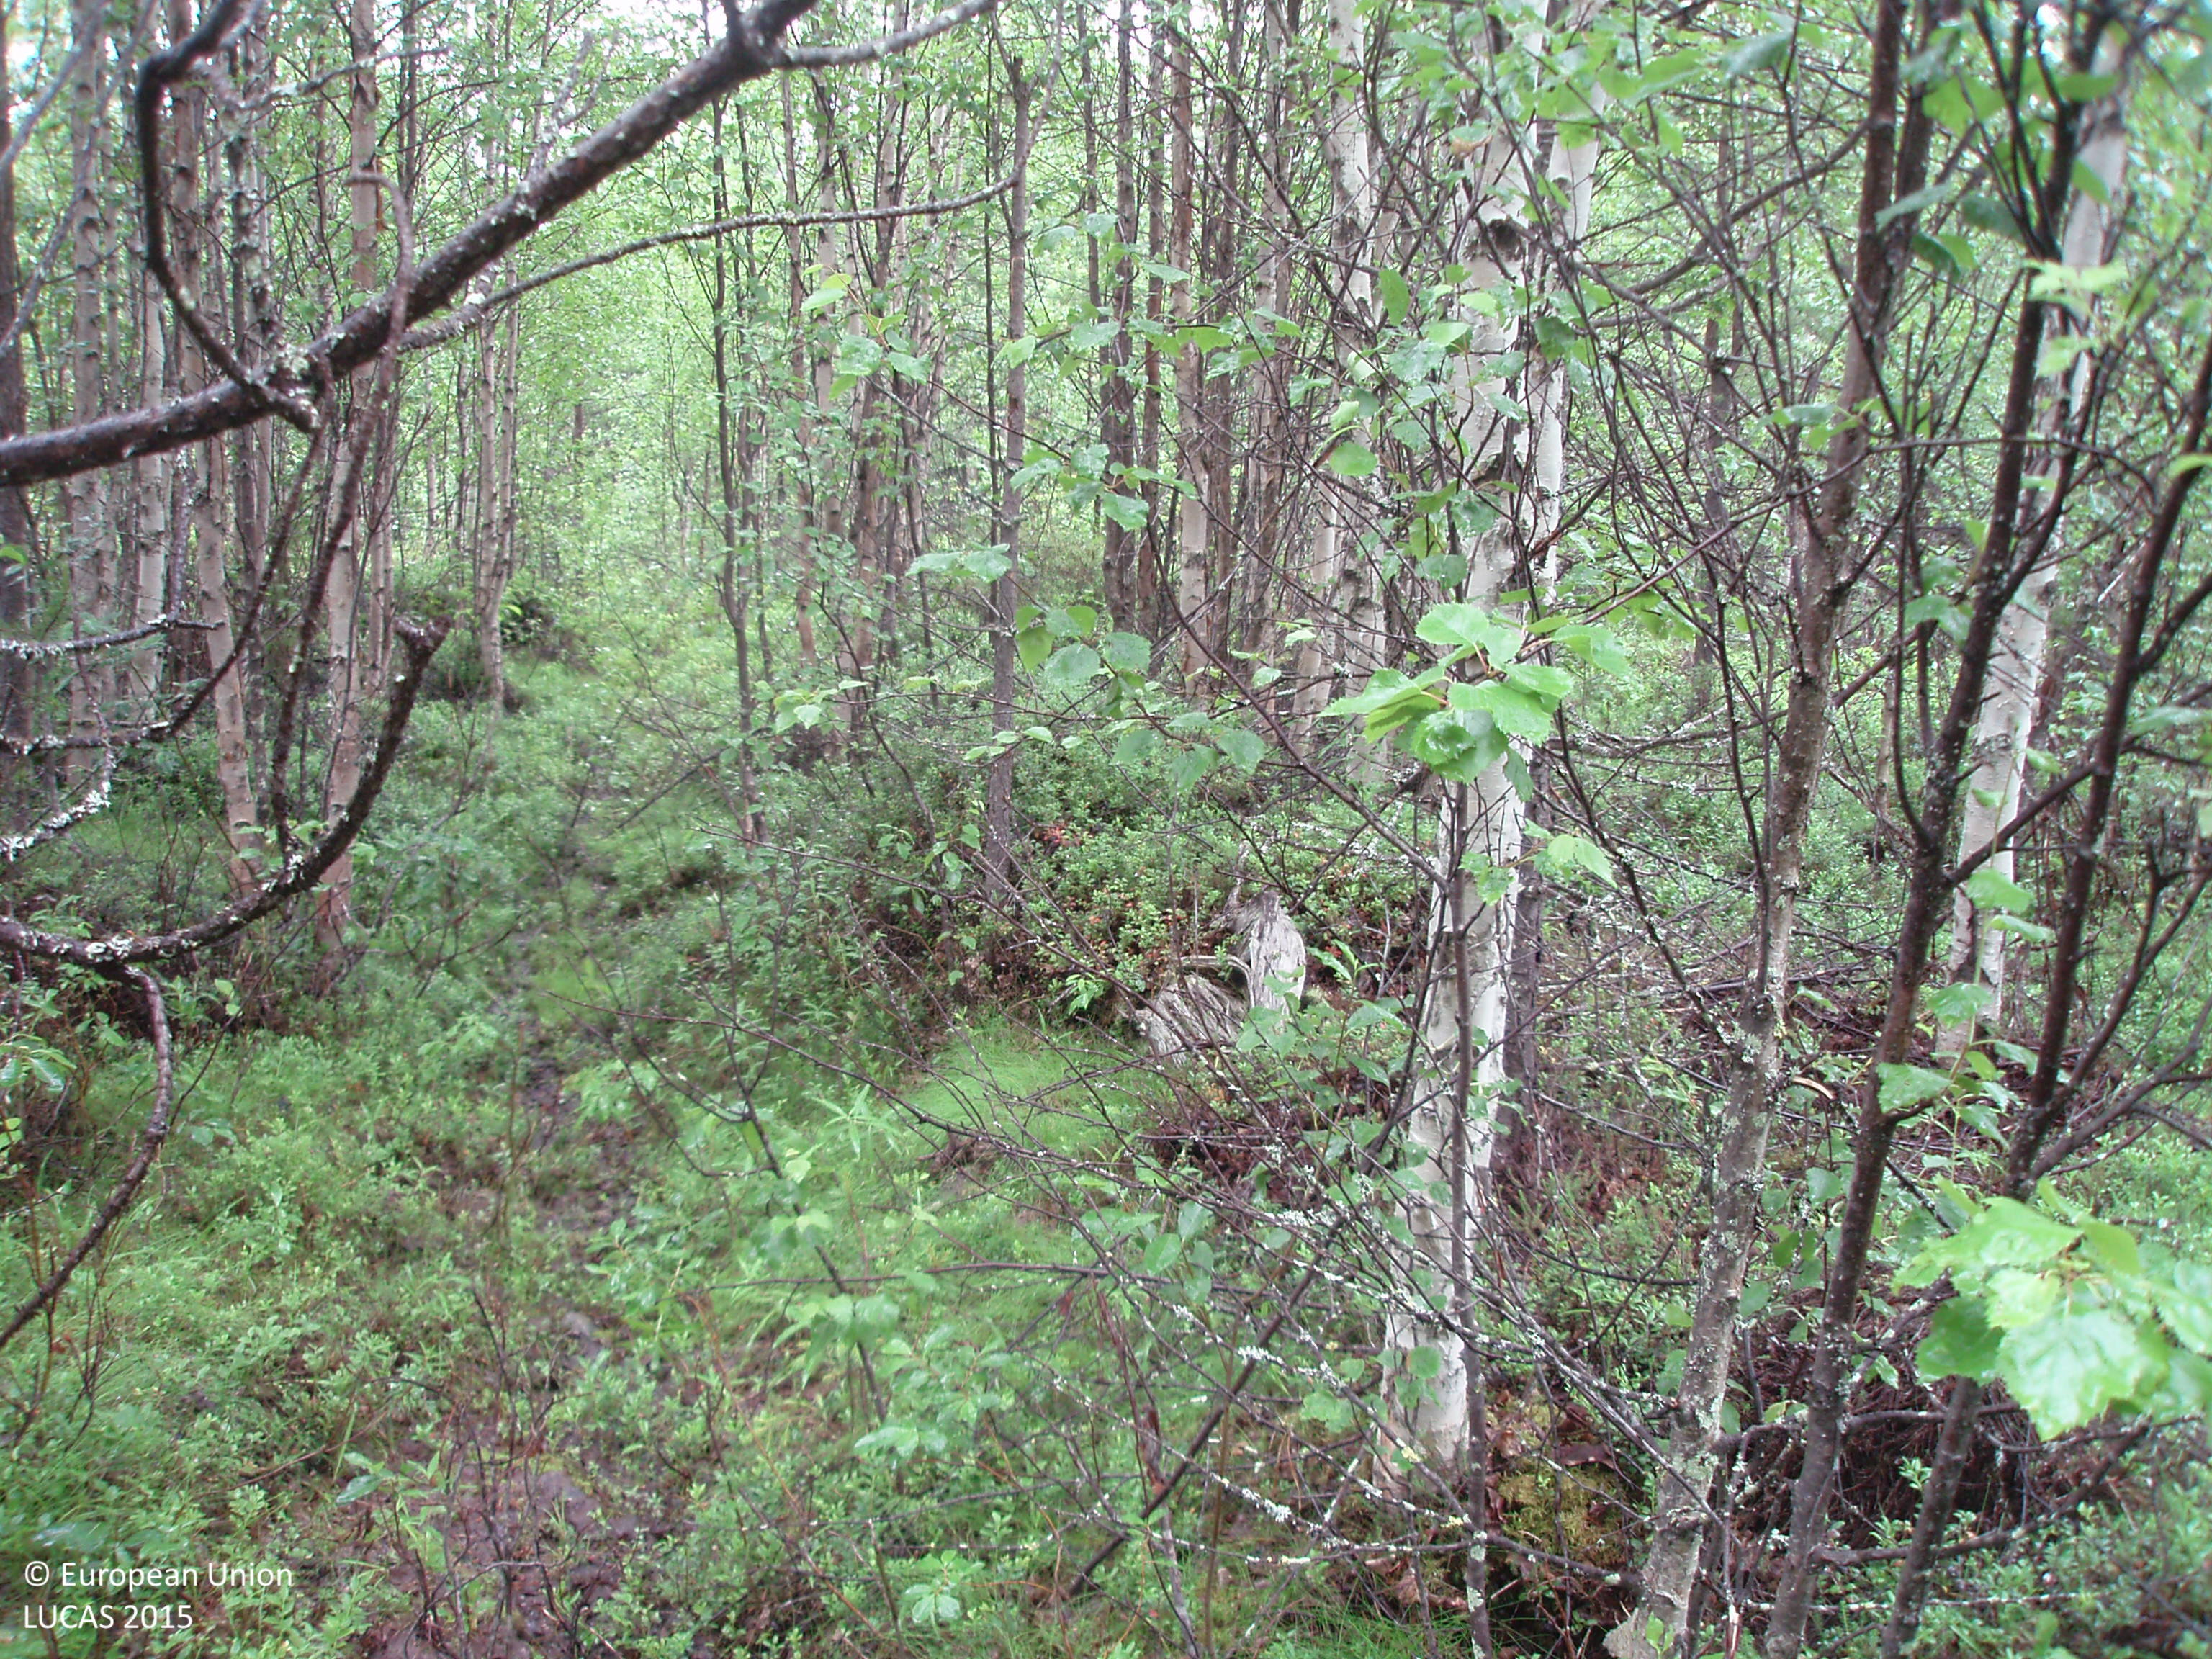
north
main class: Woodland
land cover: Pine dominated mixed woodland
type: boreal forest
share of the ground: > 75 %
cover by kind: broadleaved forest trees 50 %, coniferous forest trees 40 %, shrubs 10 %
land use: Forestry
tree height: > 5 m
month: July
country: FI
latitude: 66.8000
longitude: 28.2630
